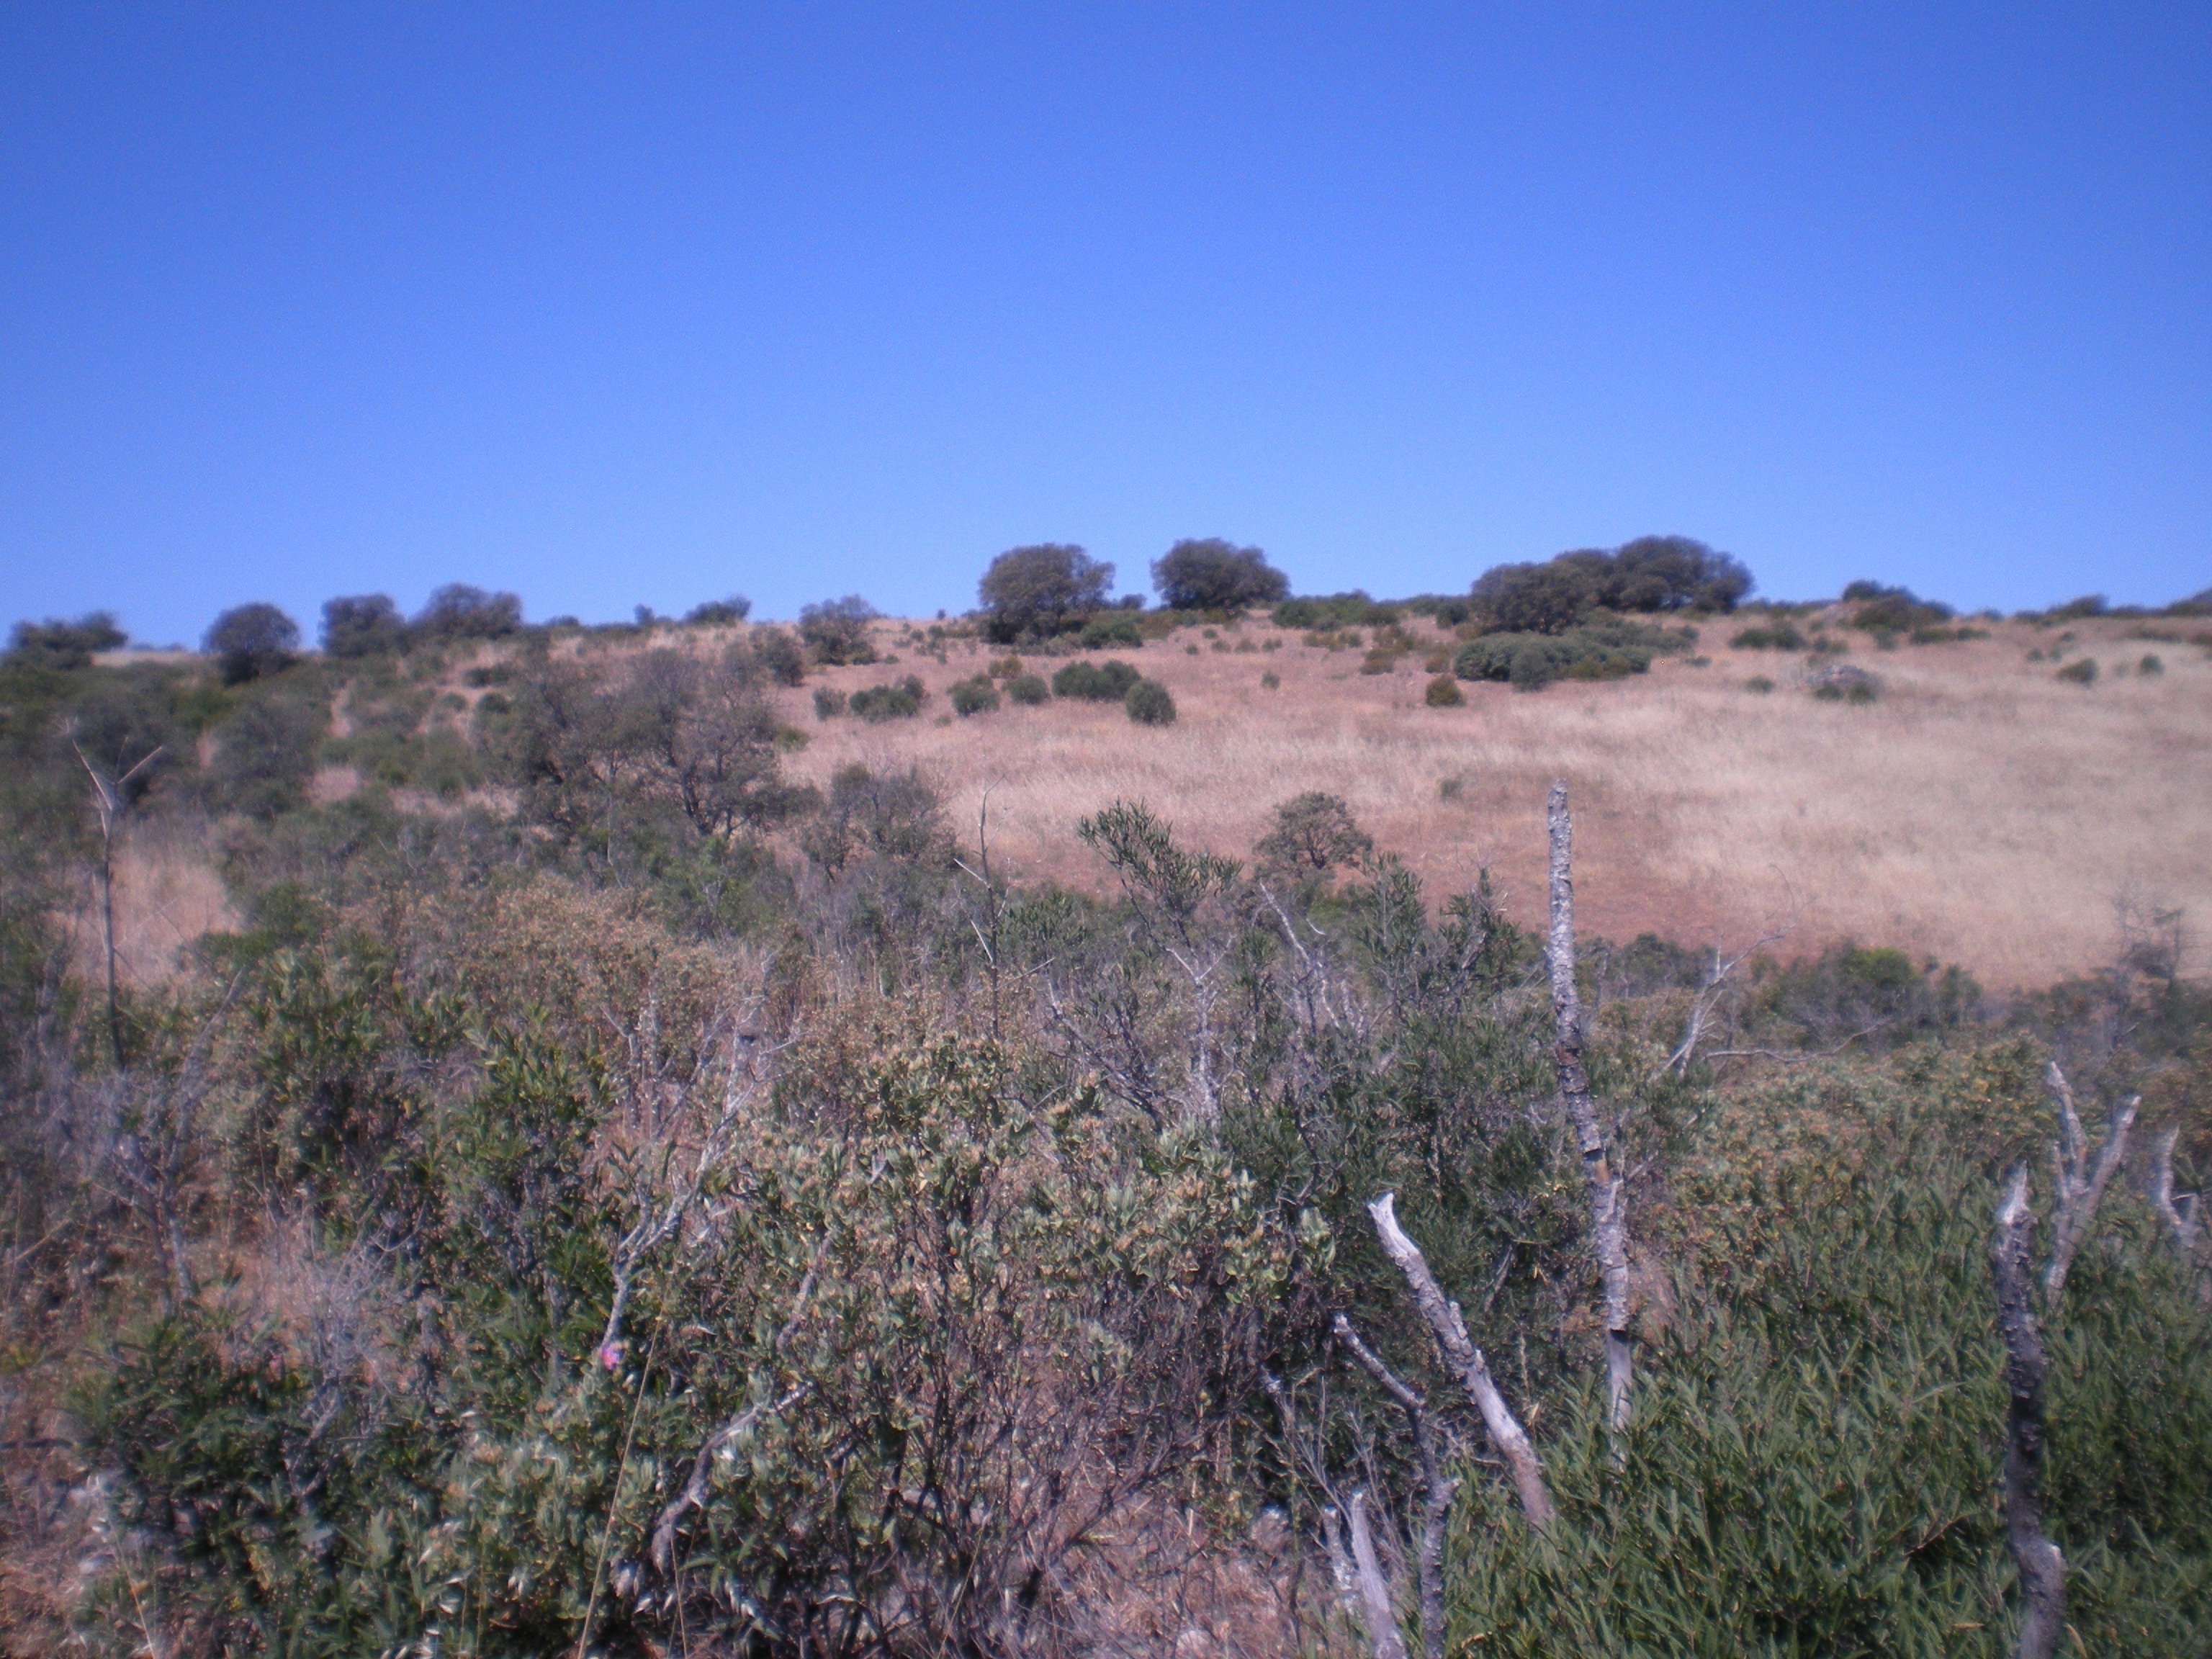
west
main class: Shrubland
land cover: Shrubland with sparse tree cover
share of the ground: > 75 %
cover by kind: shrubs 75 %, herbaceous plants 10 %, unconsolidated bare surface 10 %, broadleaved forest trees 5 %
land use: Forestry
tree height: < 5 m
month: May
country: ES
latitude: 38.4926
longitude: -3.4566
